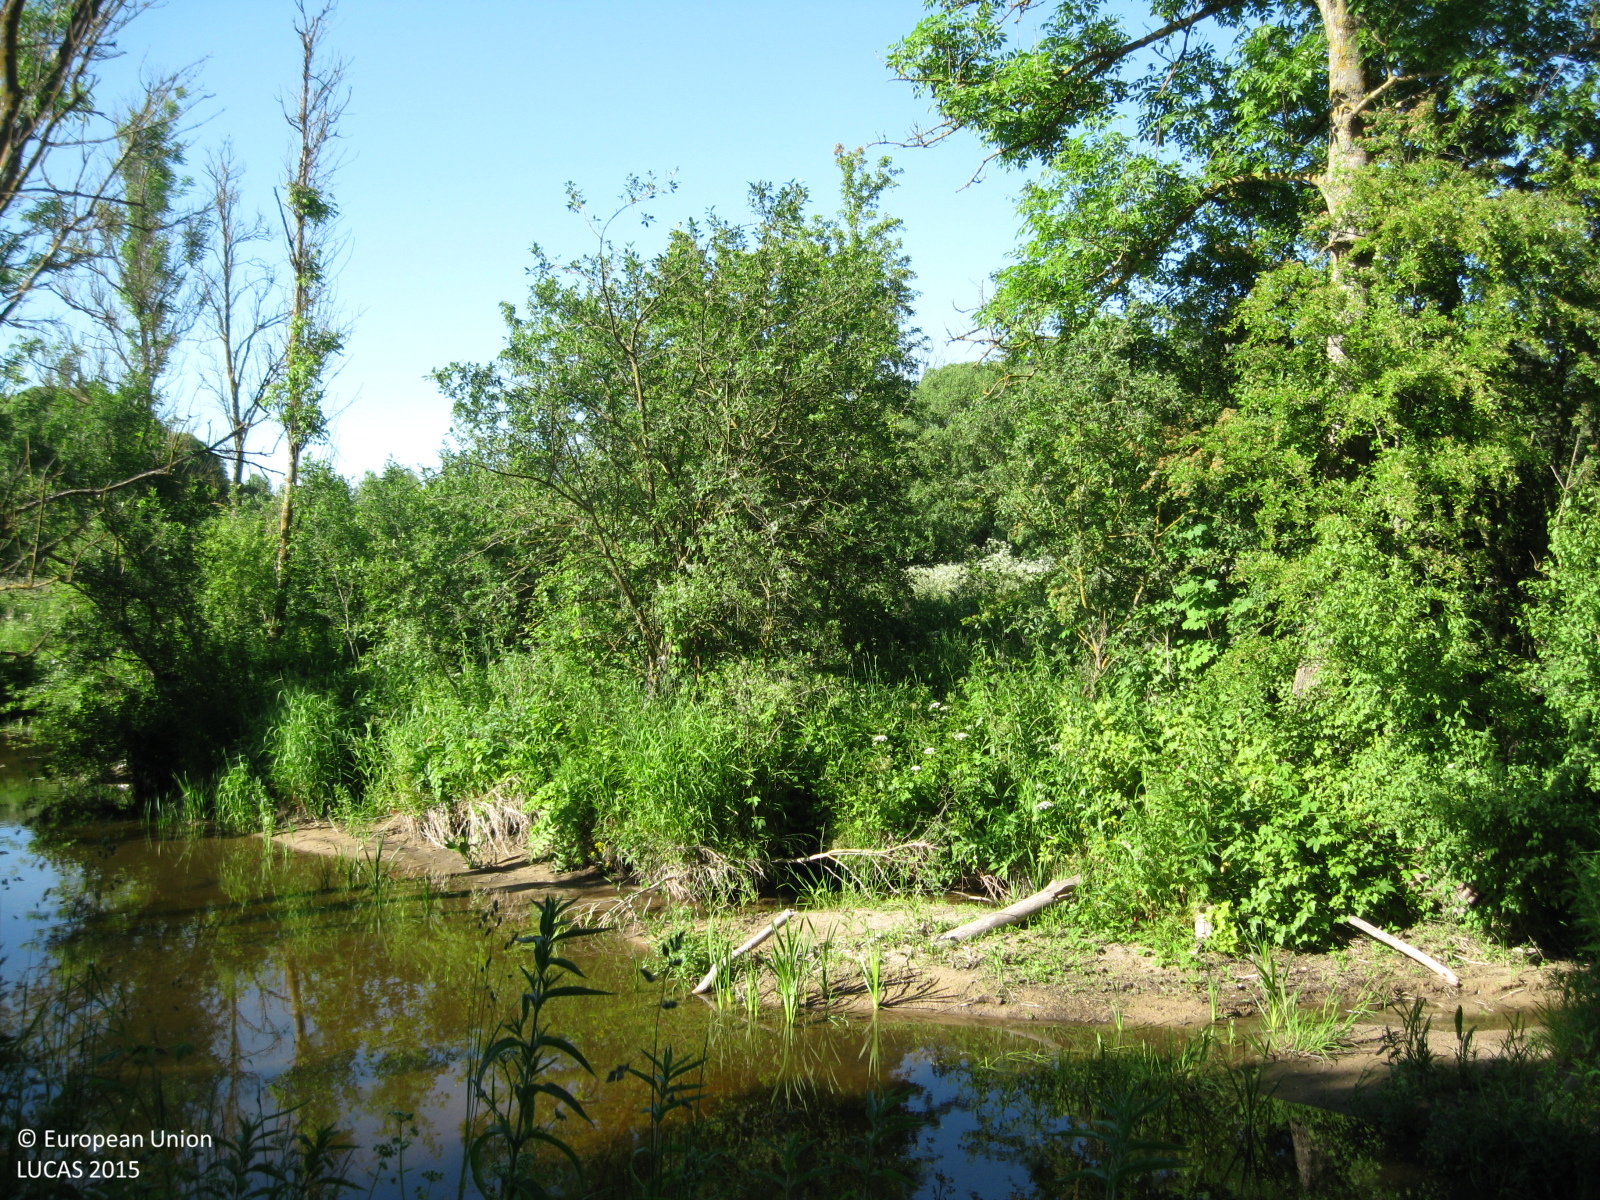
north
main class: Grassland
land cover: Spontaneously vegetated surfaces
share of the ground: > 75 %
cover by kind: herbaceous plants 100 %
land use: Semi-natural and natural areas not in use
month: June
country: LT
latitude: 55.6884
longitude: 24.0071
